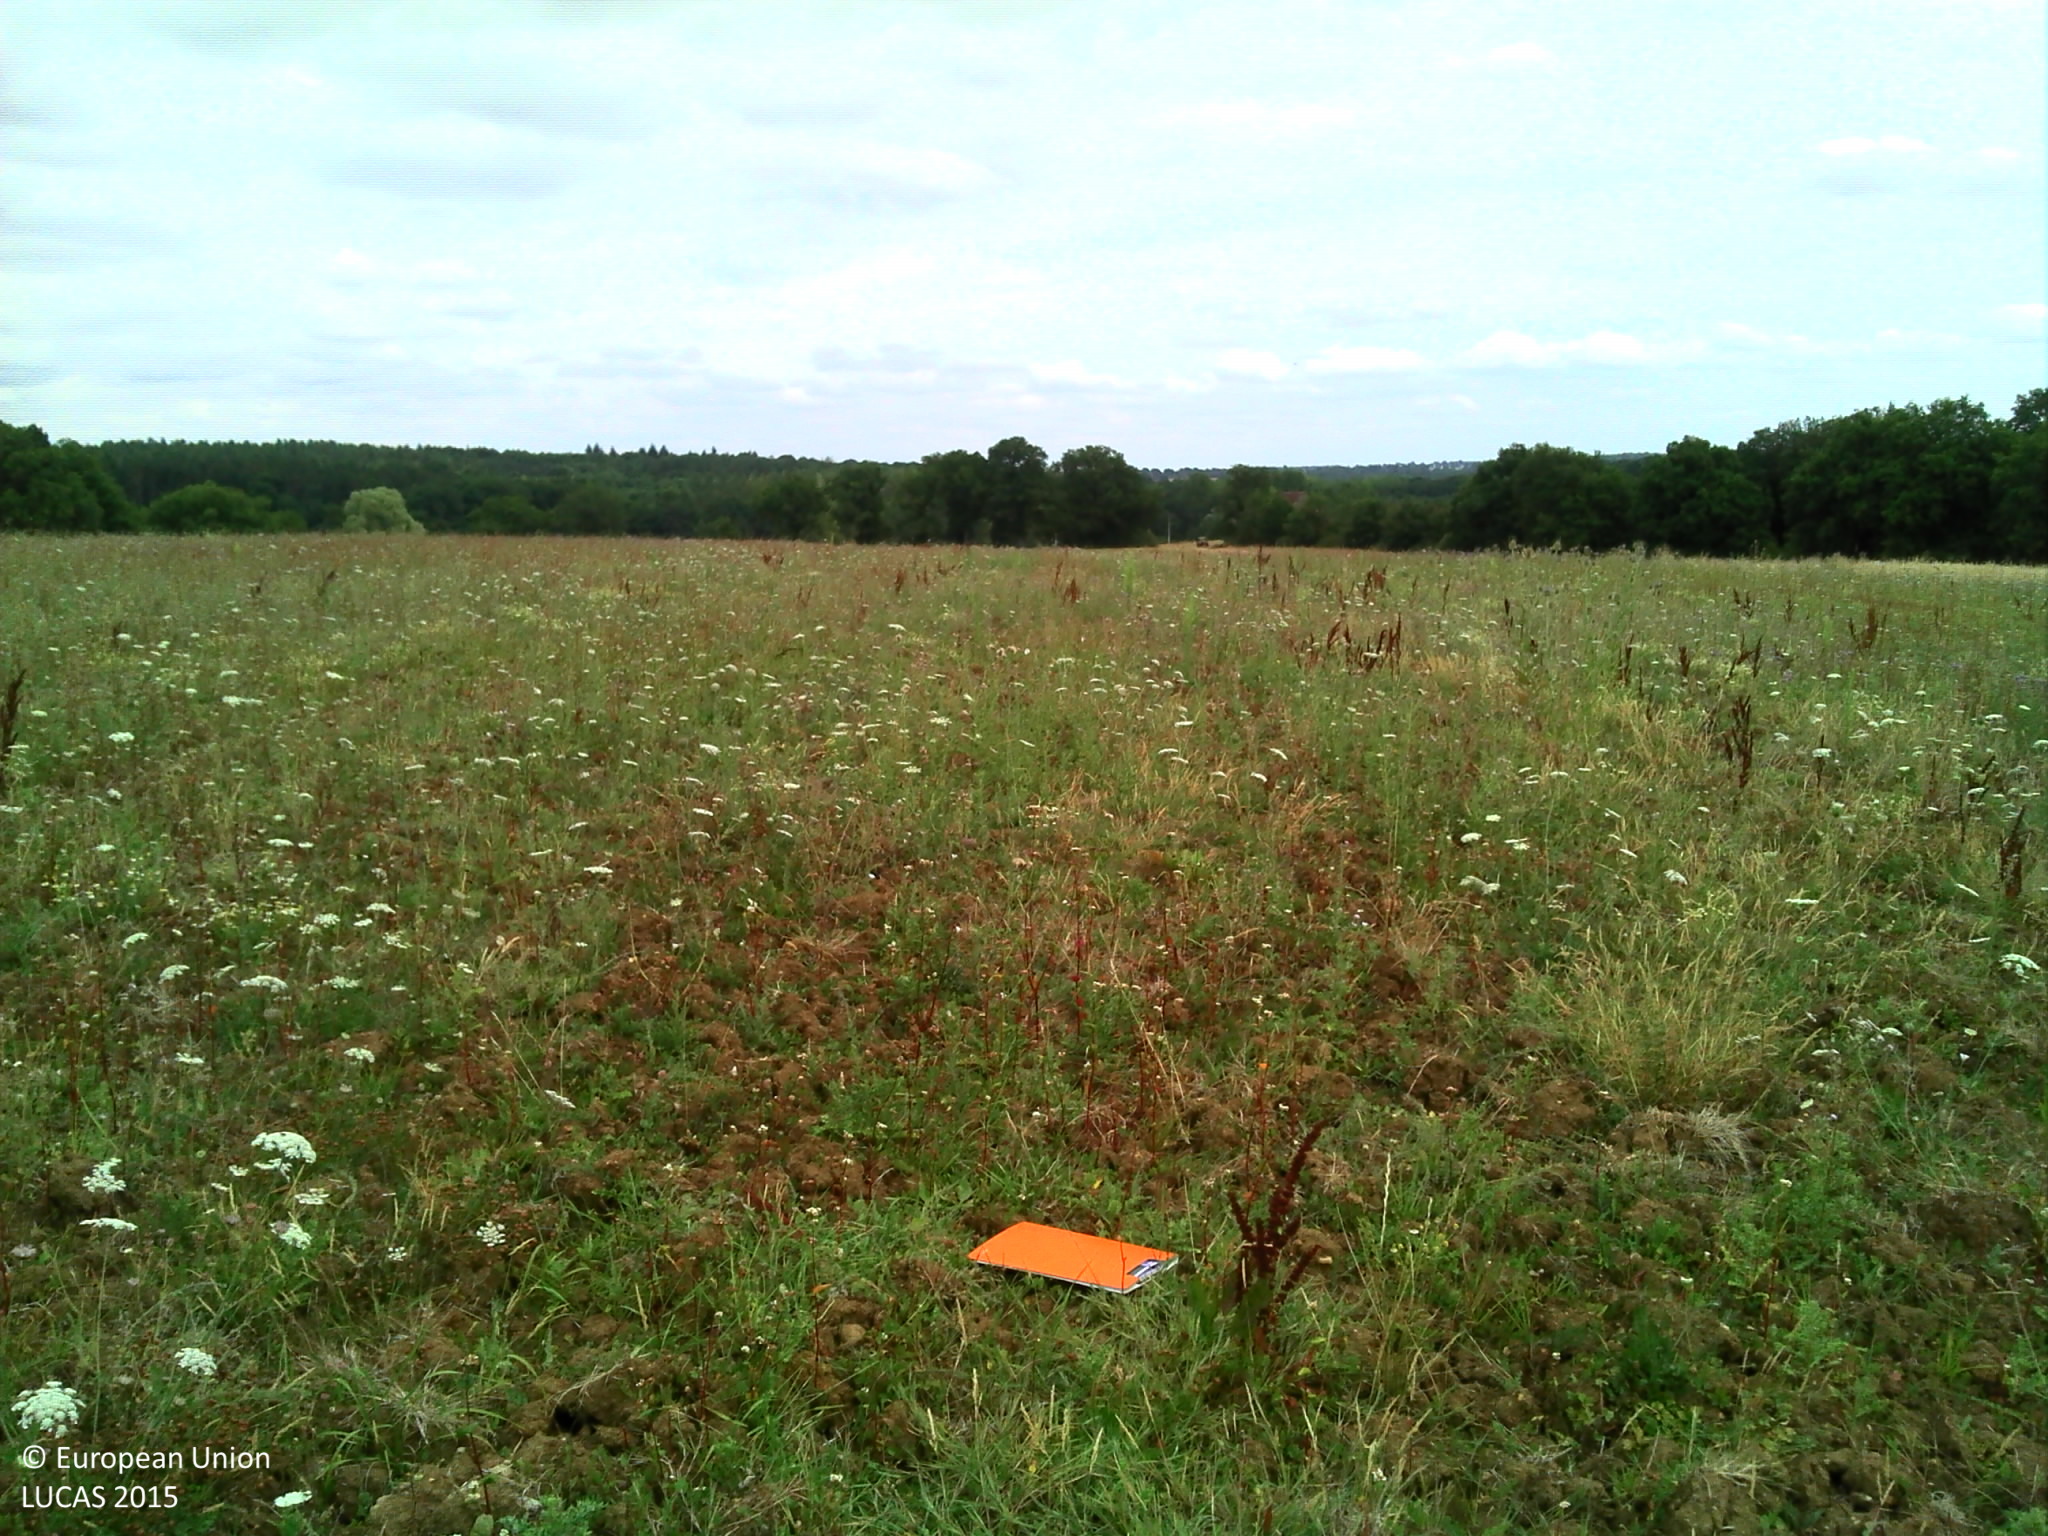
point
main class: Grassland
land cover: Spontaneously vegetated surfaces
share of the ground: > 75 %
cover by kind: herbaceous plants 100 %
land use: Fallow land
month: July
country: FR
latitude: 46.6626
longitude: 2.9784
